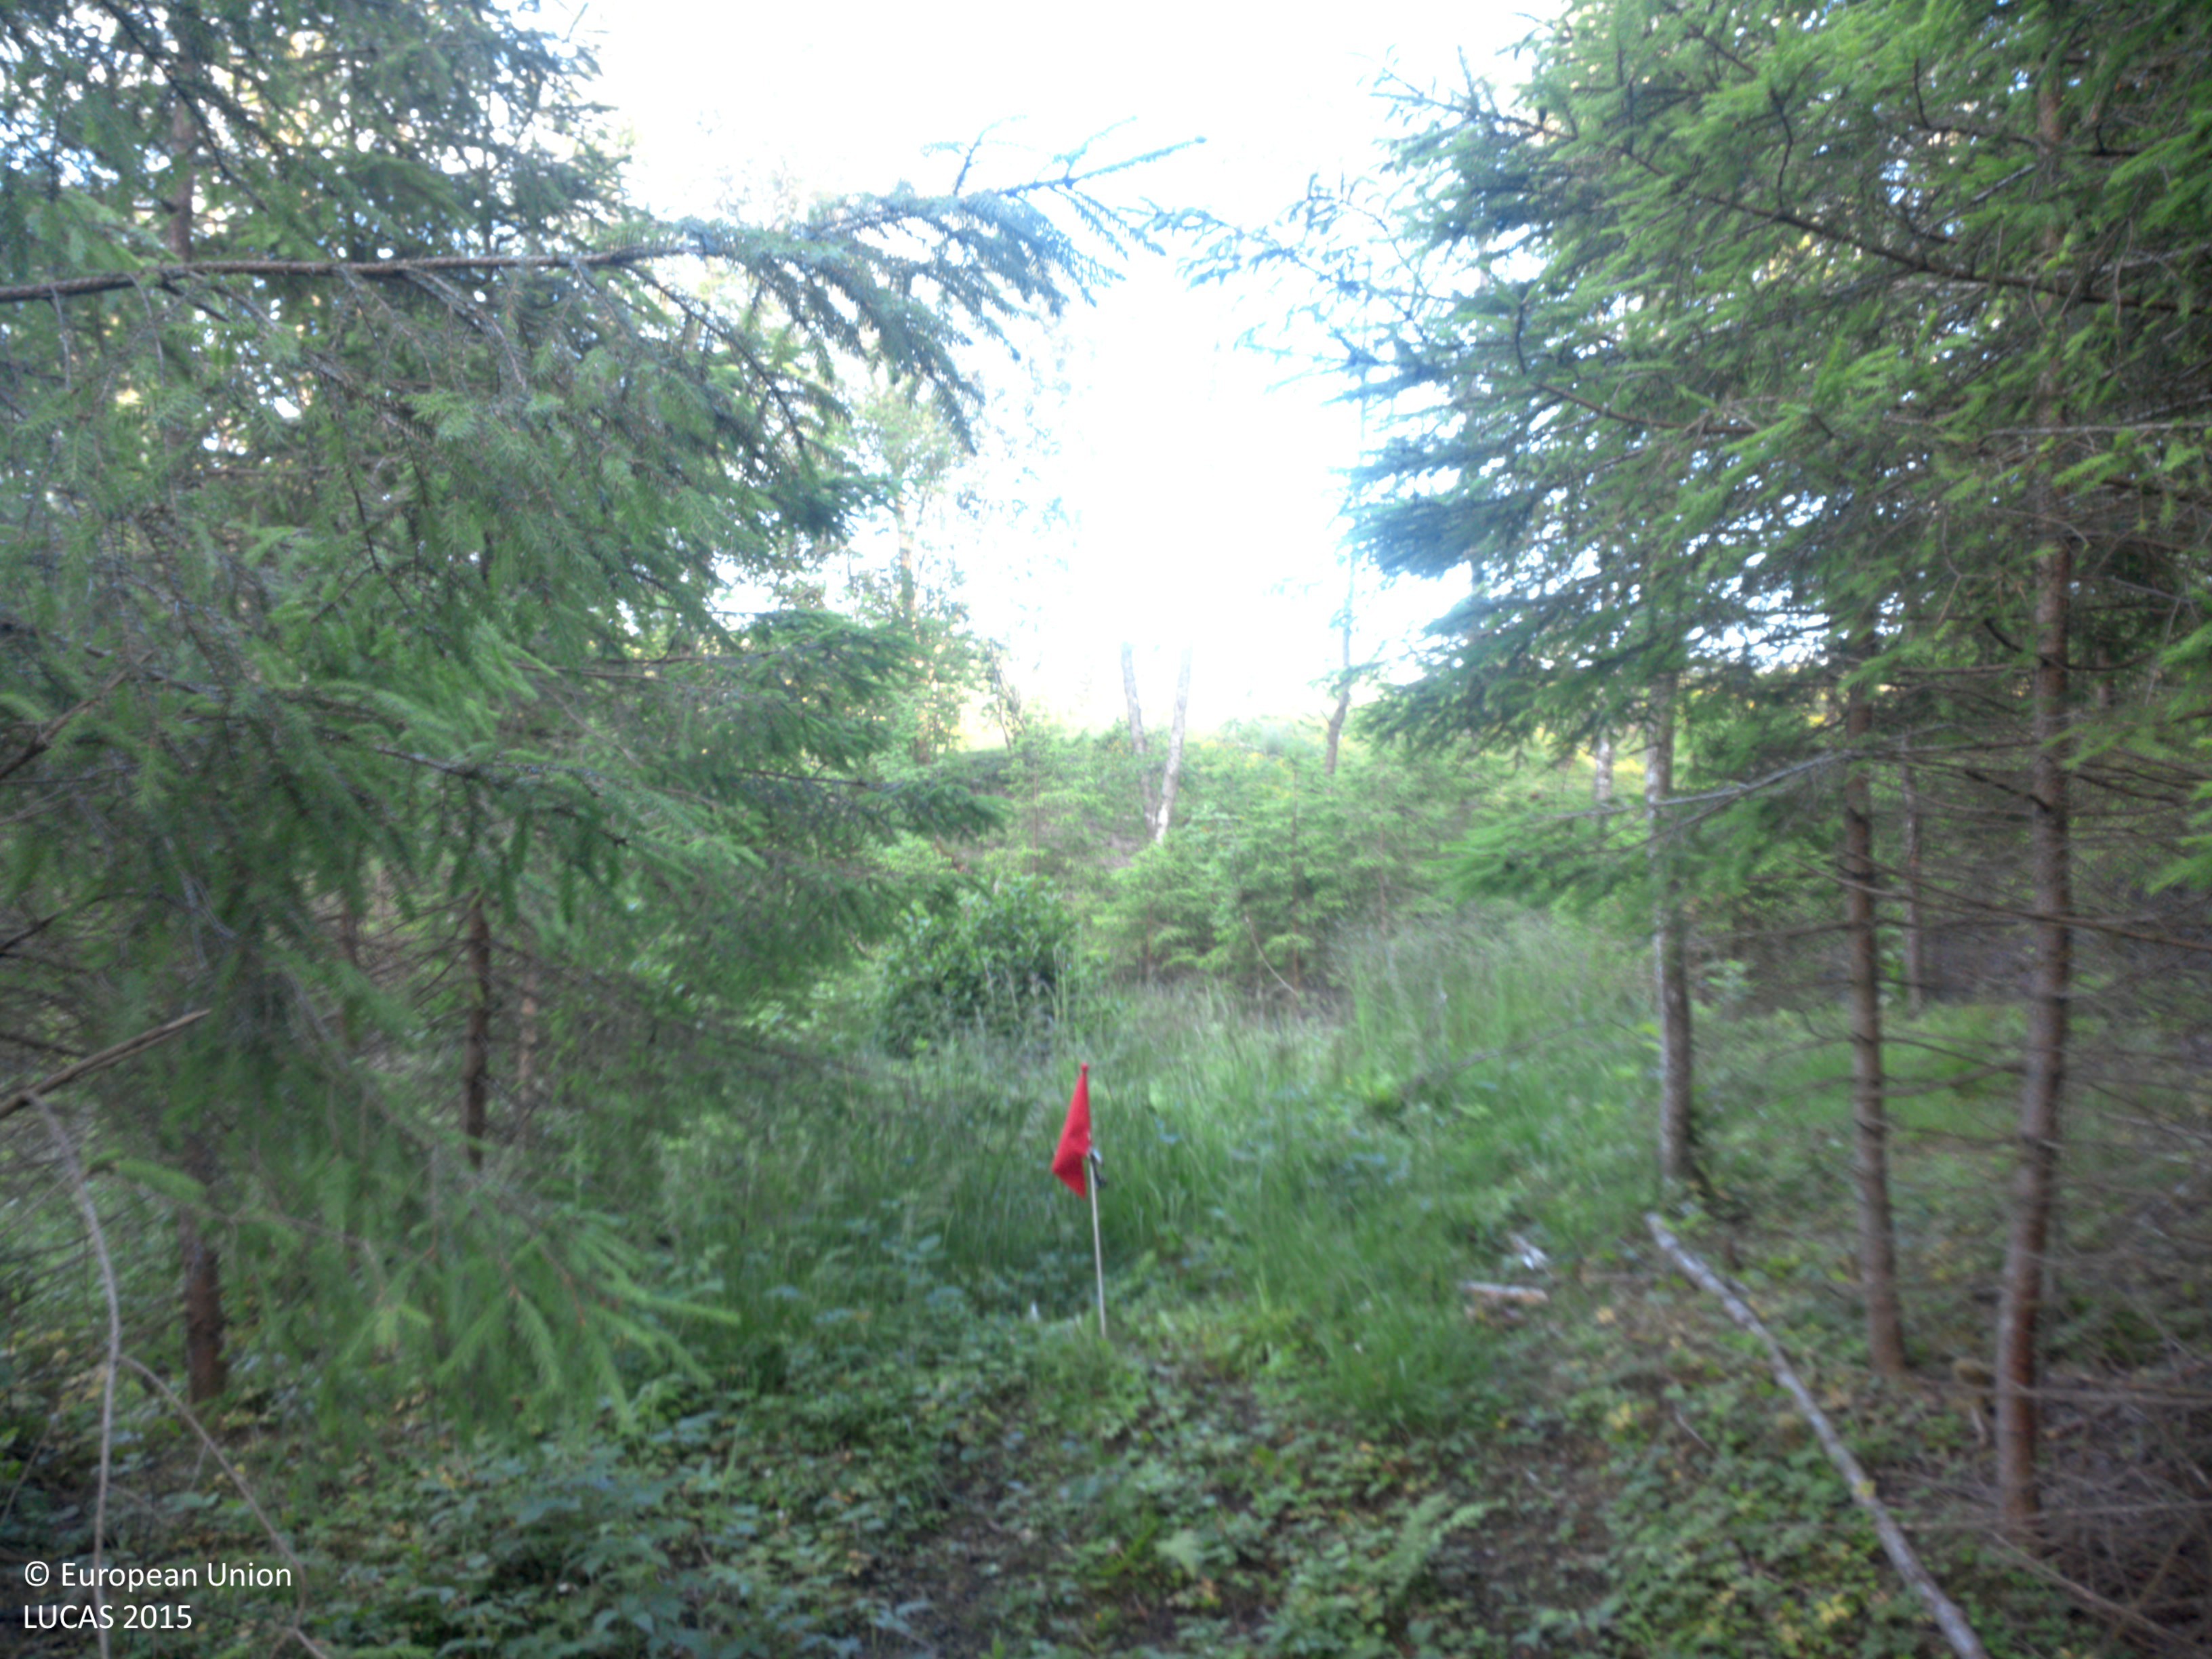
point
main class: Woodland
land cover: Spruce dominated mixed woodland
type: boreal forest
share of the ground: 25 - 50 %
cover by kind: herbaceous plants 40 %, coniferous forest trees 30 %, broadleaved forest trees 15 %, shrubs 15 %
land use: Forestry
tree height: < 5 m
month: June
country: SE
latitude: 58.8224
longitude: 11.5378
